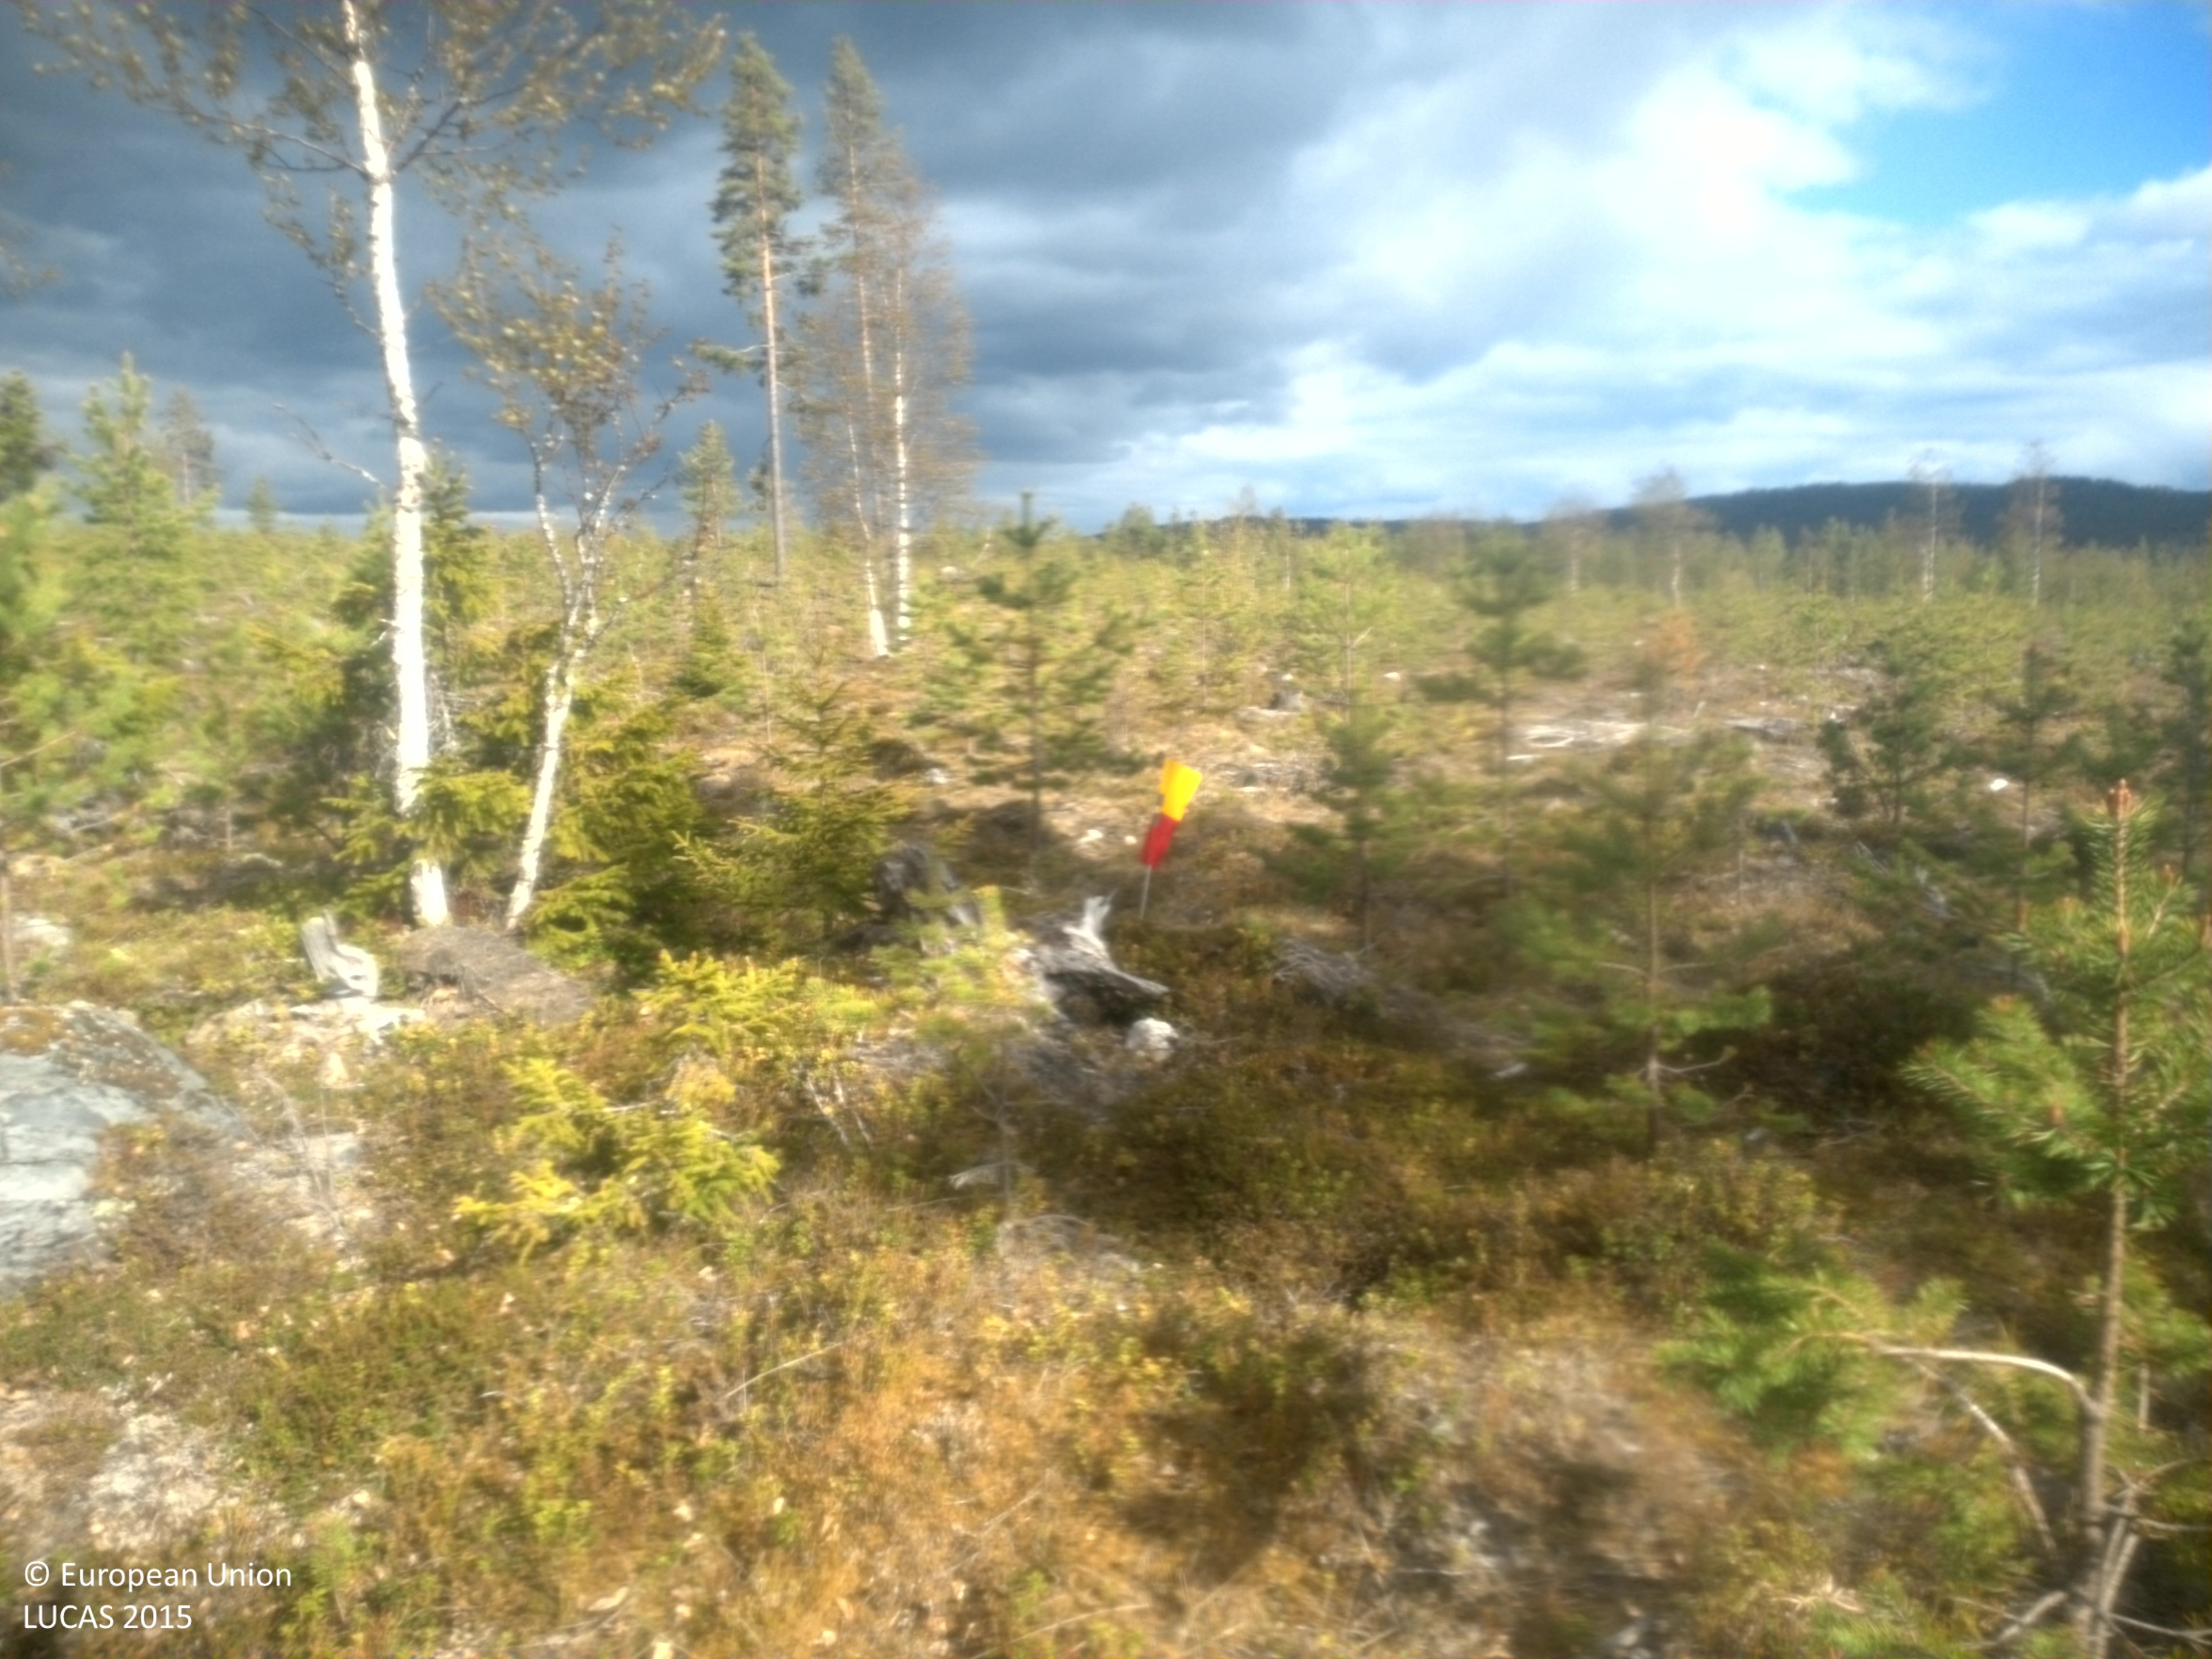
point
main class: Woodland
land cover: Pine dominated coniferous woodland
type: boreal forest
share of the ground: 10 - 25 %
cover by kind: herbaceous plants 35 %, lichens and mosses 25 %, coniferous forest trees 20 %, unconsolidated bare surface 10 %, broadleaved forest trees 5 %, shrubs 5 %
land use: Forestry
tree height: < 5 m
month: June
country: SE
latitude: 64.3746
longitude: 17.6981
